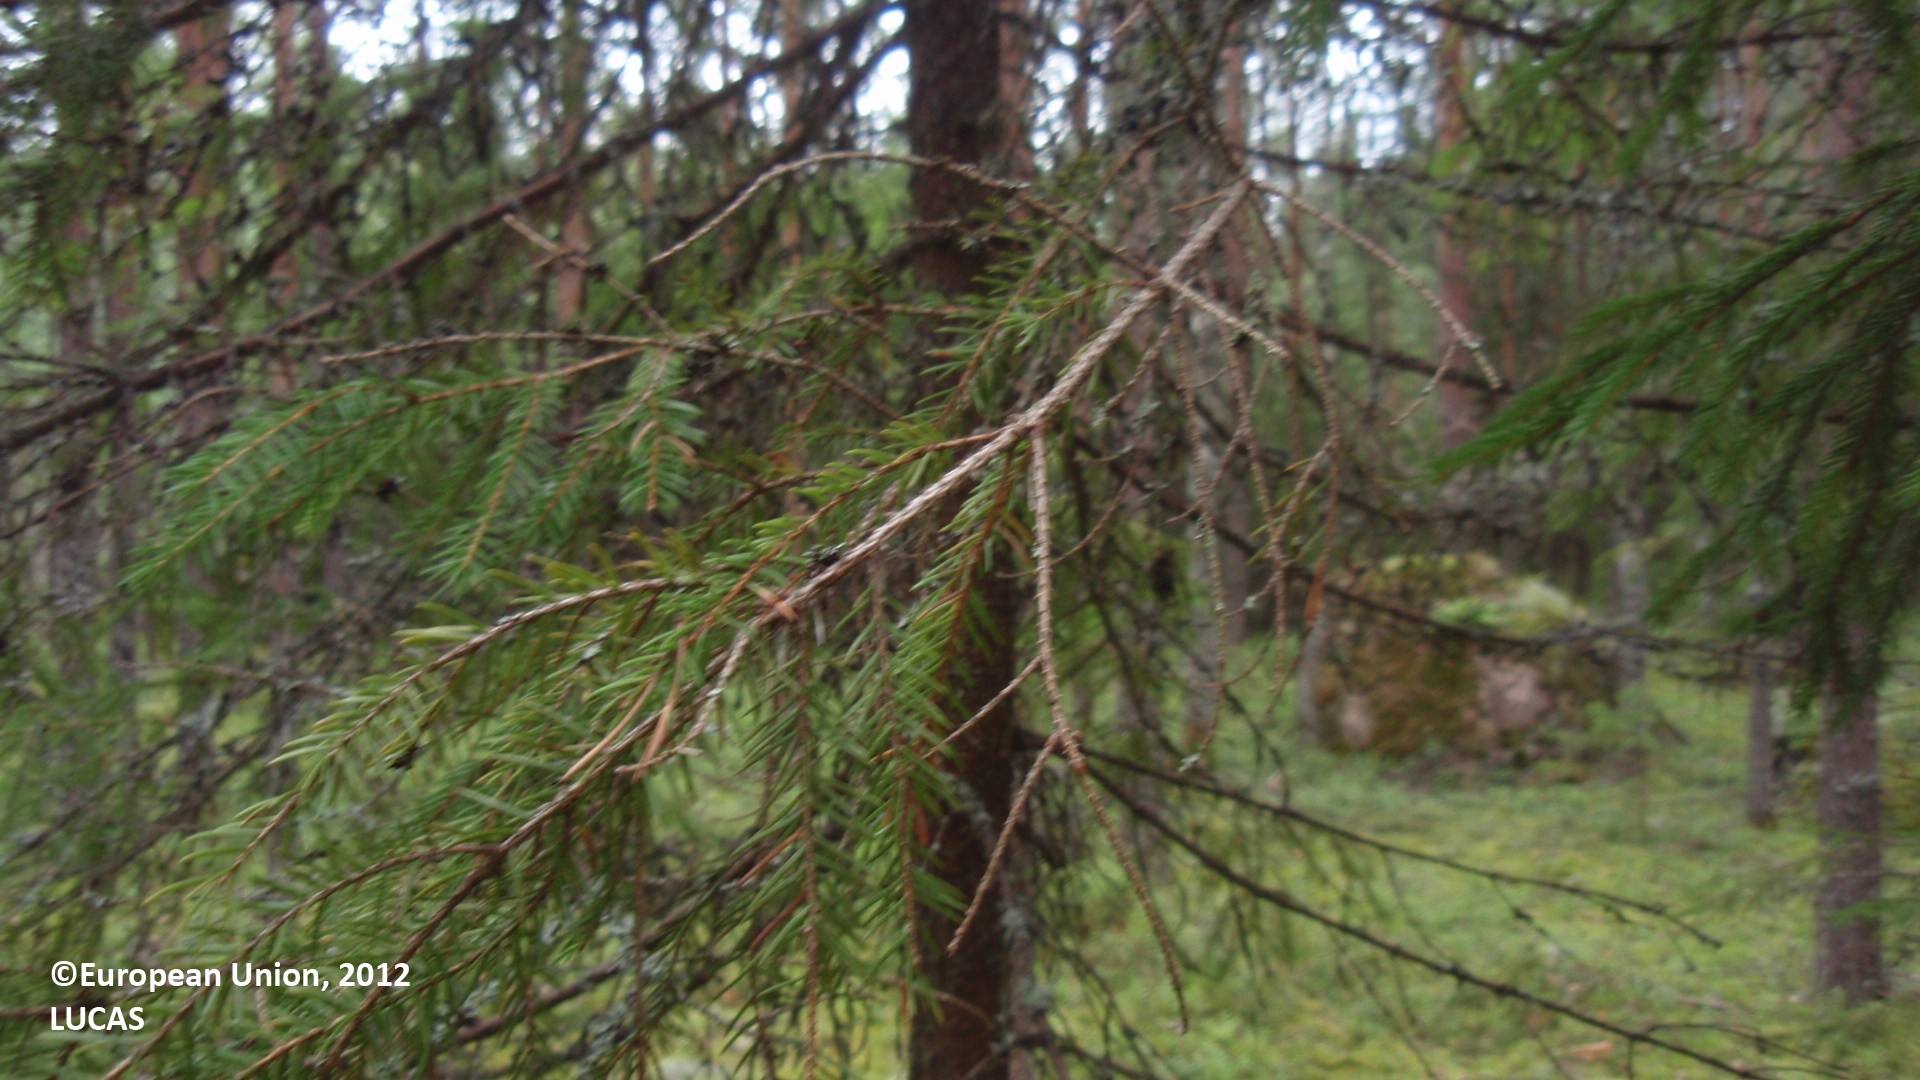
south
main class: Woodland
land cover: Pine dominated mixed woodland
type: boreal forest
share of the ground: 50 - 75 %
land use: Forestry
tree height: > 5 m
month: August
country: FI
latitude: 60.9331
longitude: 27.4334
